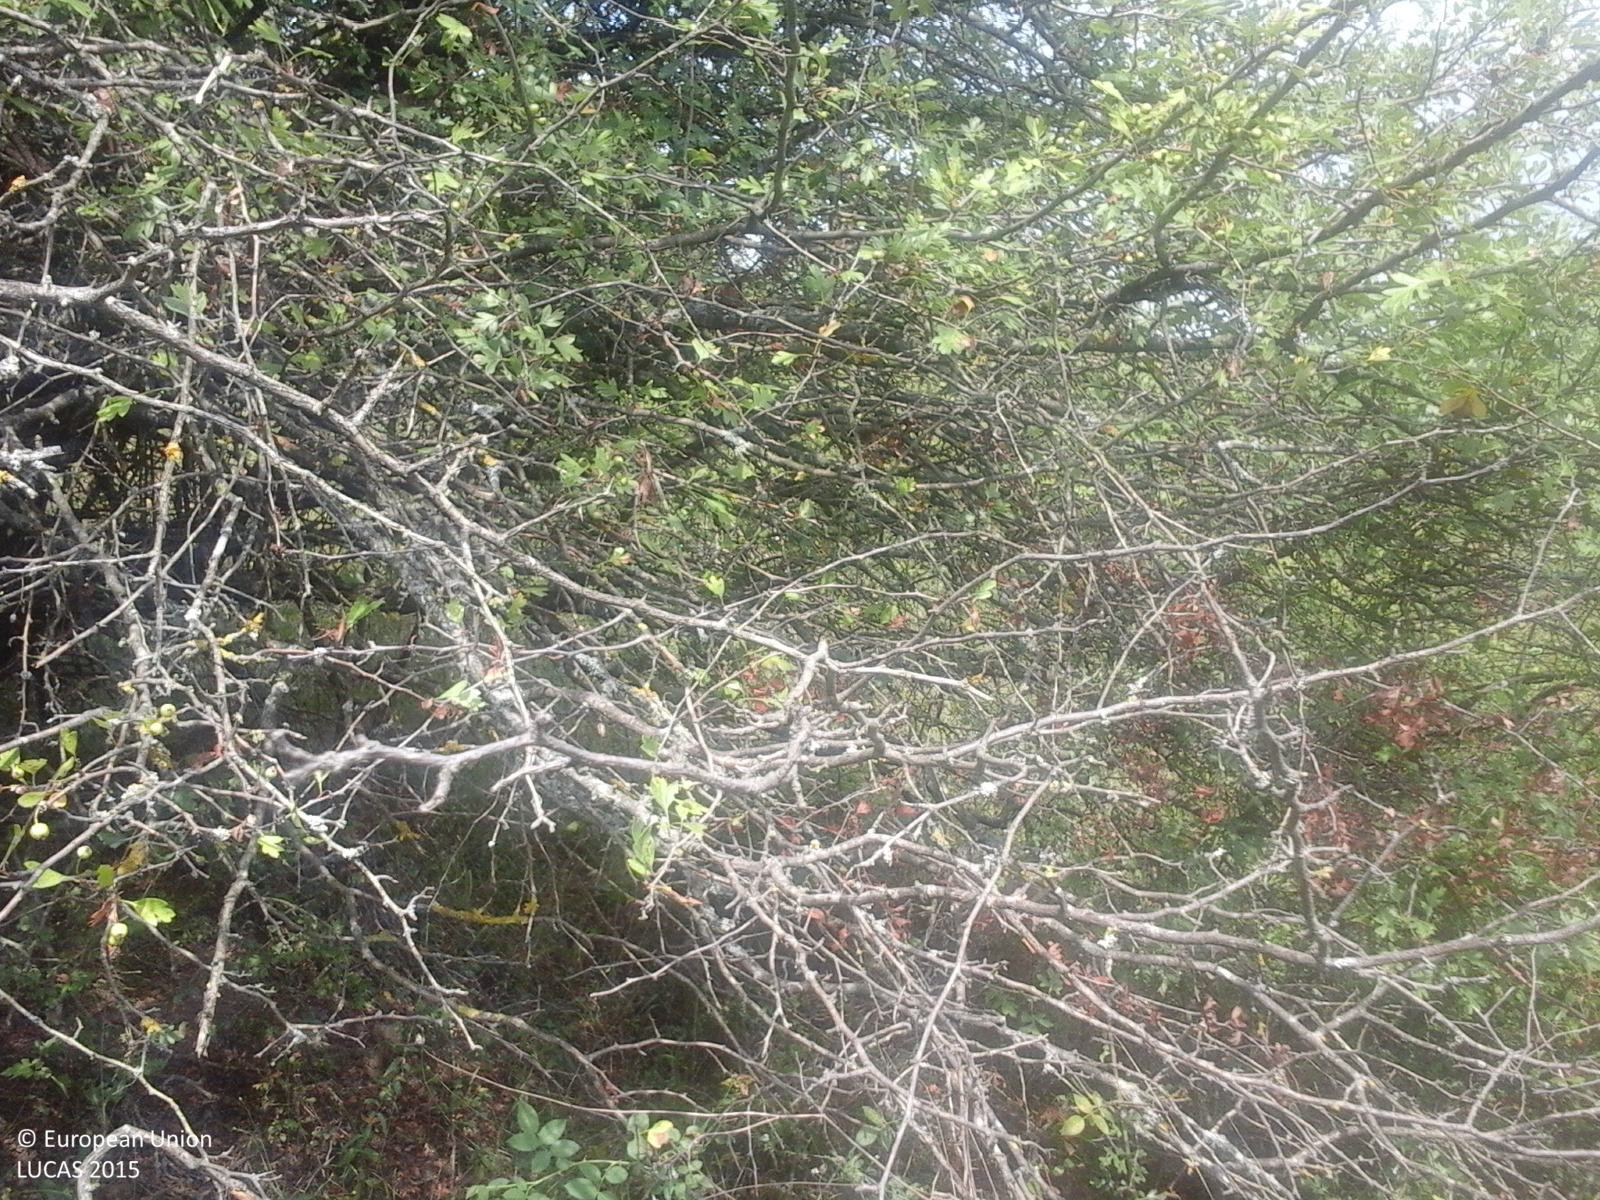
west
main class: Shrubland
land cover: Shrubland with sparse tree cover
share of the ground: > 75 %
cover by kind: herbaceous plants 85 %, shrubs 10 %, broadleaved forest trees 5 %
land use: Fallow land
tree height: > 5 m
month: August
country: RO
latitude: 44.0704
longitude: 27.7886
